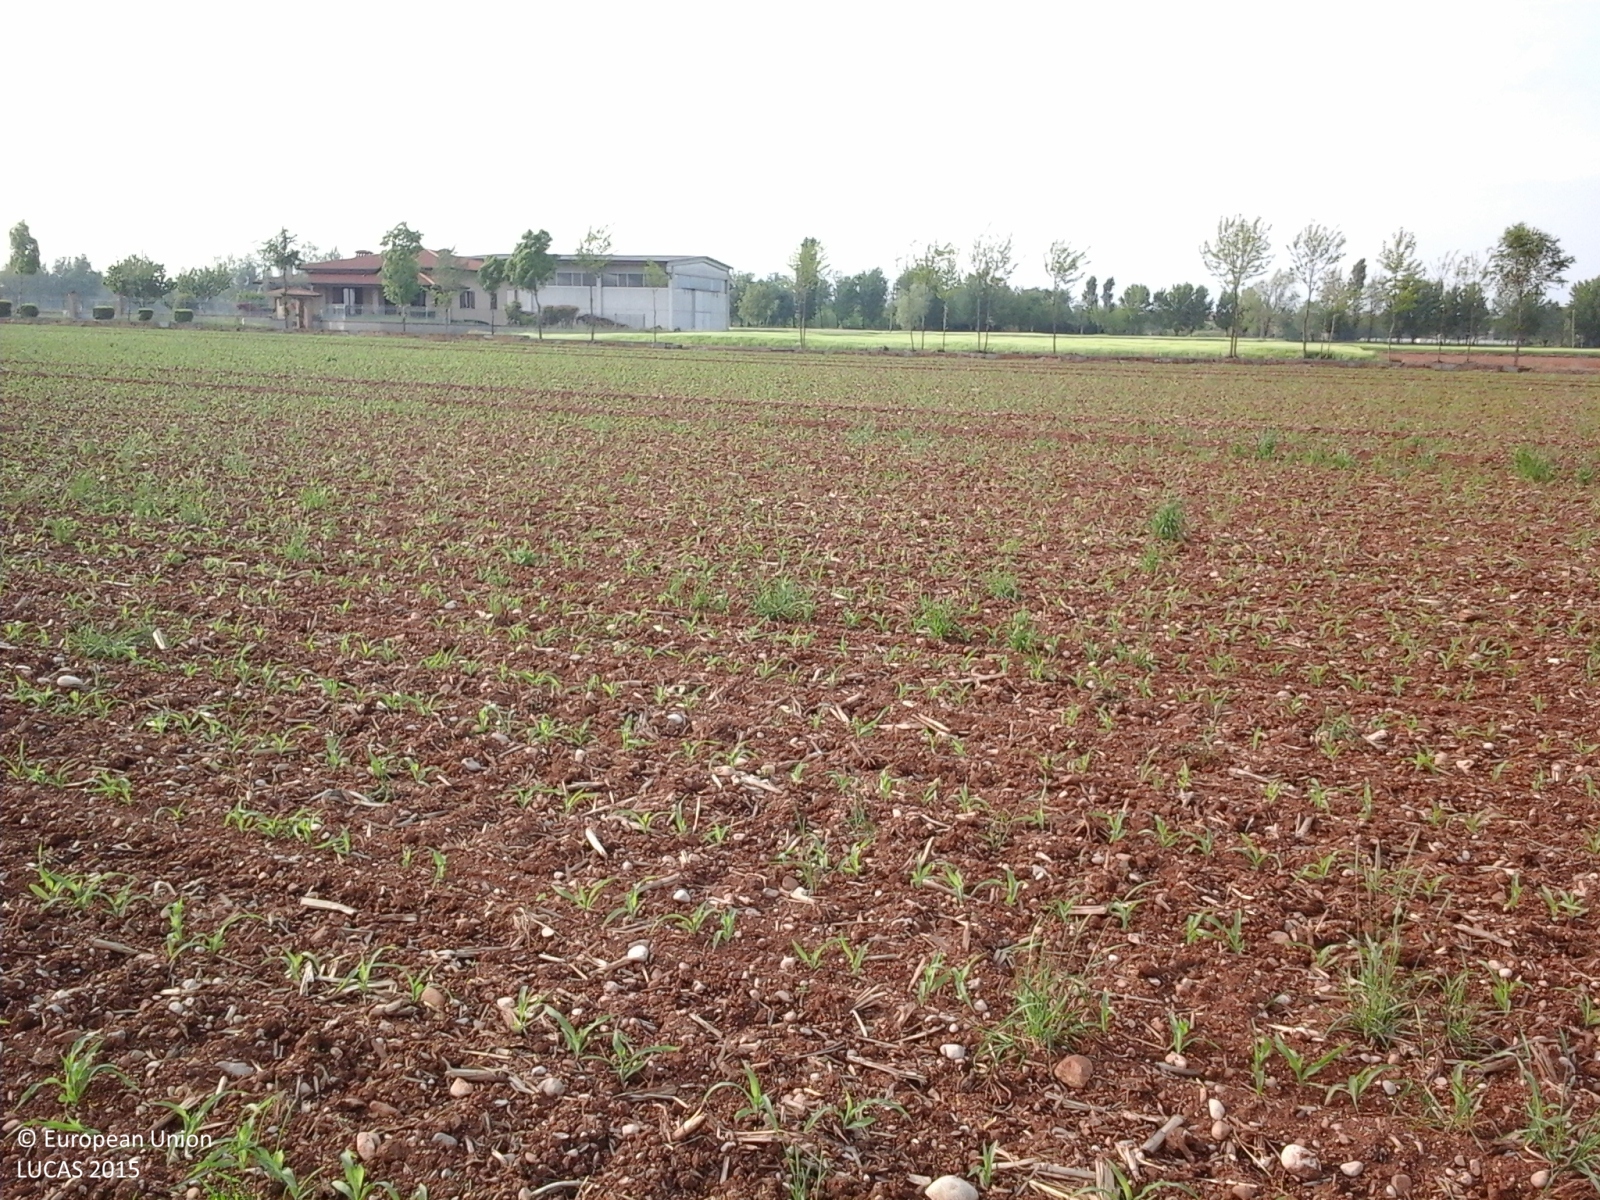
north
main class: Cropland
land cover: Maize
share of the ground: < 10 %
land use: Agriculture (excluding fallow land and kitchen gardens)
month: April
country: IT
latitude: 45.4134
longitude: 10.4209
